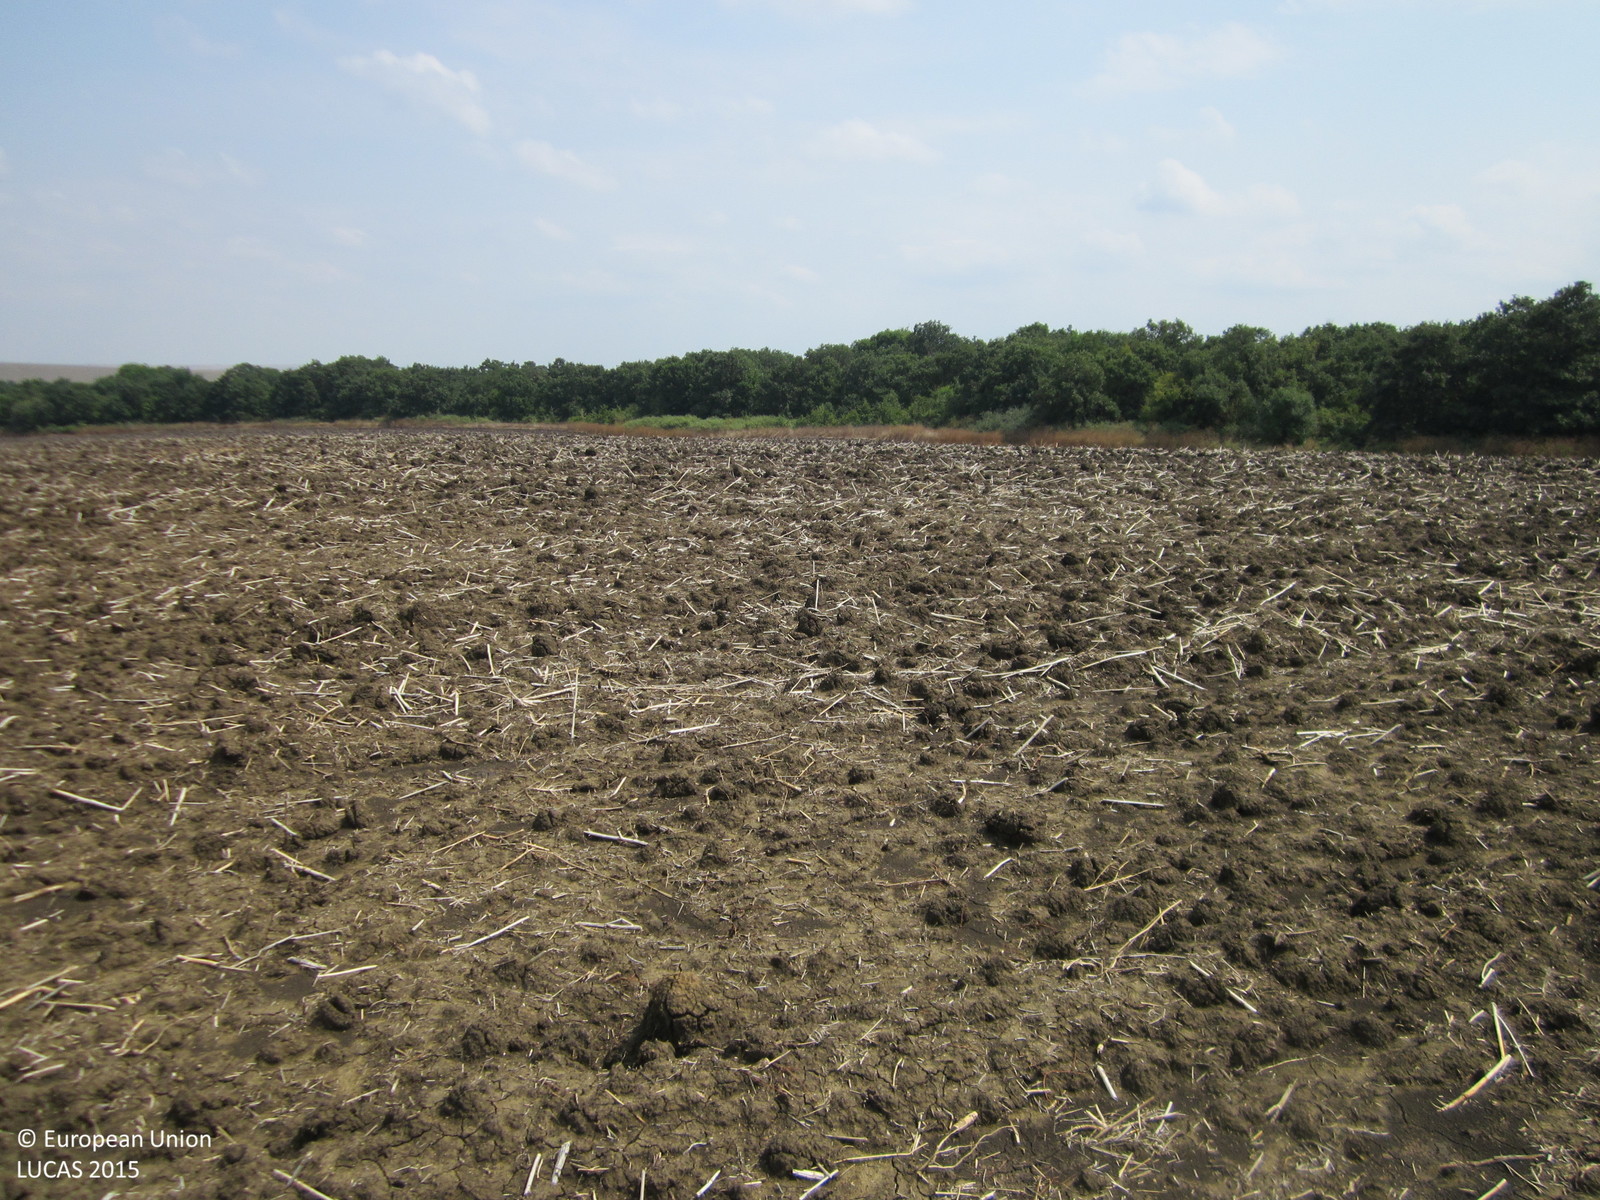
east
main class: Cropland
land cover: Sunflower
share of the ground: < 10 %
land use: Agriculture (excluding fallow land and kitchen gardens)
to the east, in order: Sunflower
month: August
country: BG
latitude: 42.5048
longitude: 26.9334
